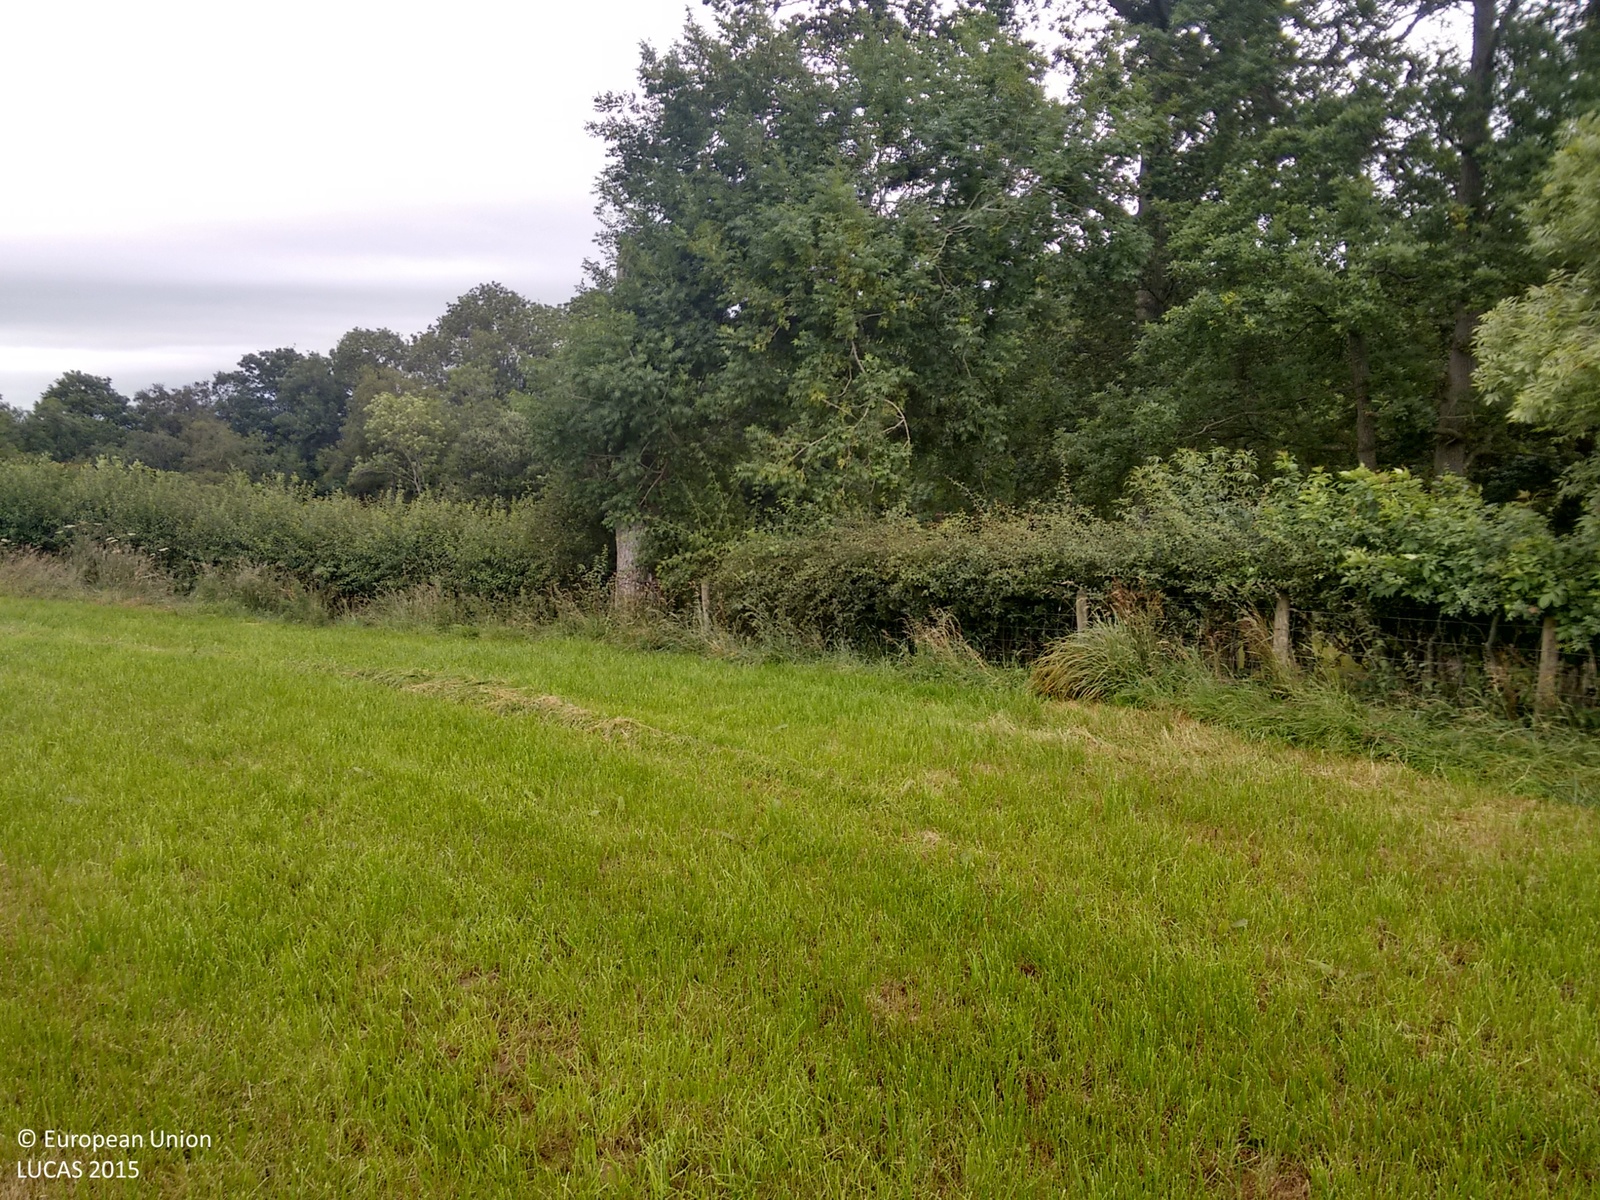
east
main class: Grassland
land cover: Grassland without tree/shrub cover
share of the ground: > 75 %
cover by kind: herbaceous plants 100 %
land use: Agriculture (excluding fallow land and kitchen gardens)
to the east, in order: Grassland without tree/shrub cover; Fences; Managed hedges; Fences; Grassland with sparse tree/shrub cover; Fences; Grass margins; Paved roads, cycling and walking lanes; Grassland without tree/shrub cover; Fences; Managed hedges; Grassland without tree/shrub cover; Broadleaved woodland; Rivers and streams; Broadleaved woodland; Grassland without tree/shrub cover
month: August
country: GB
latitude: 54.7617
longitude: -2.9545
